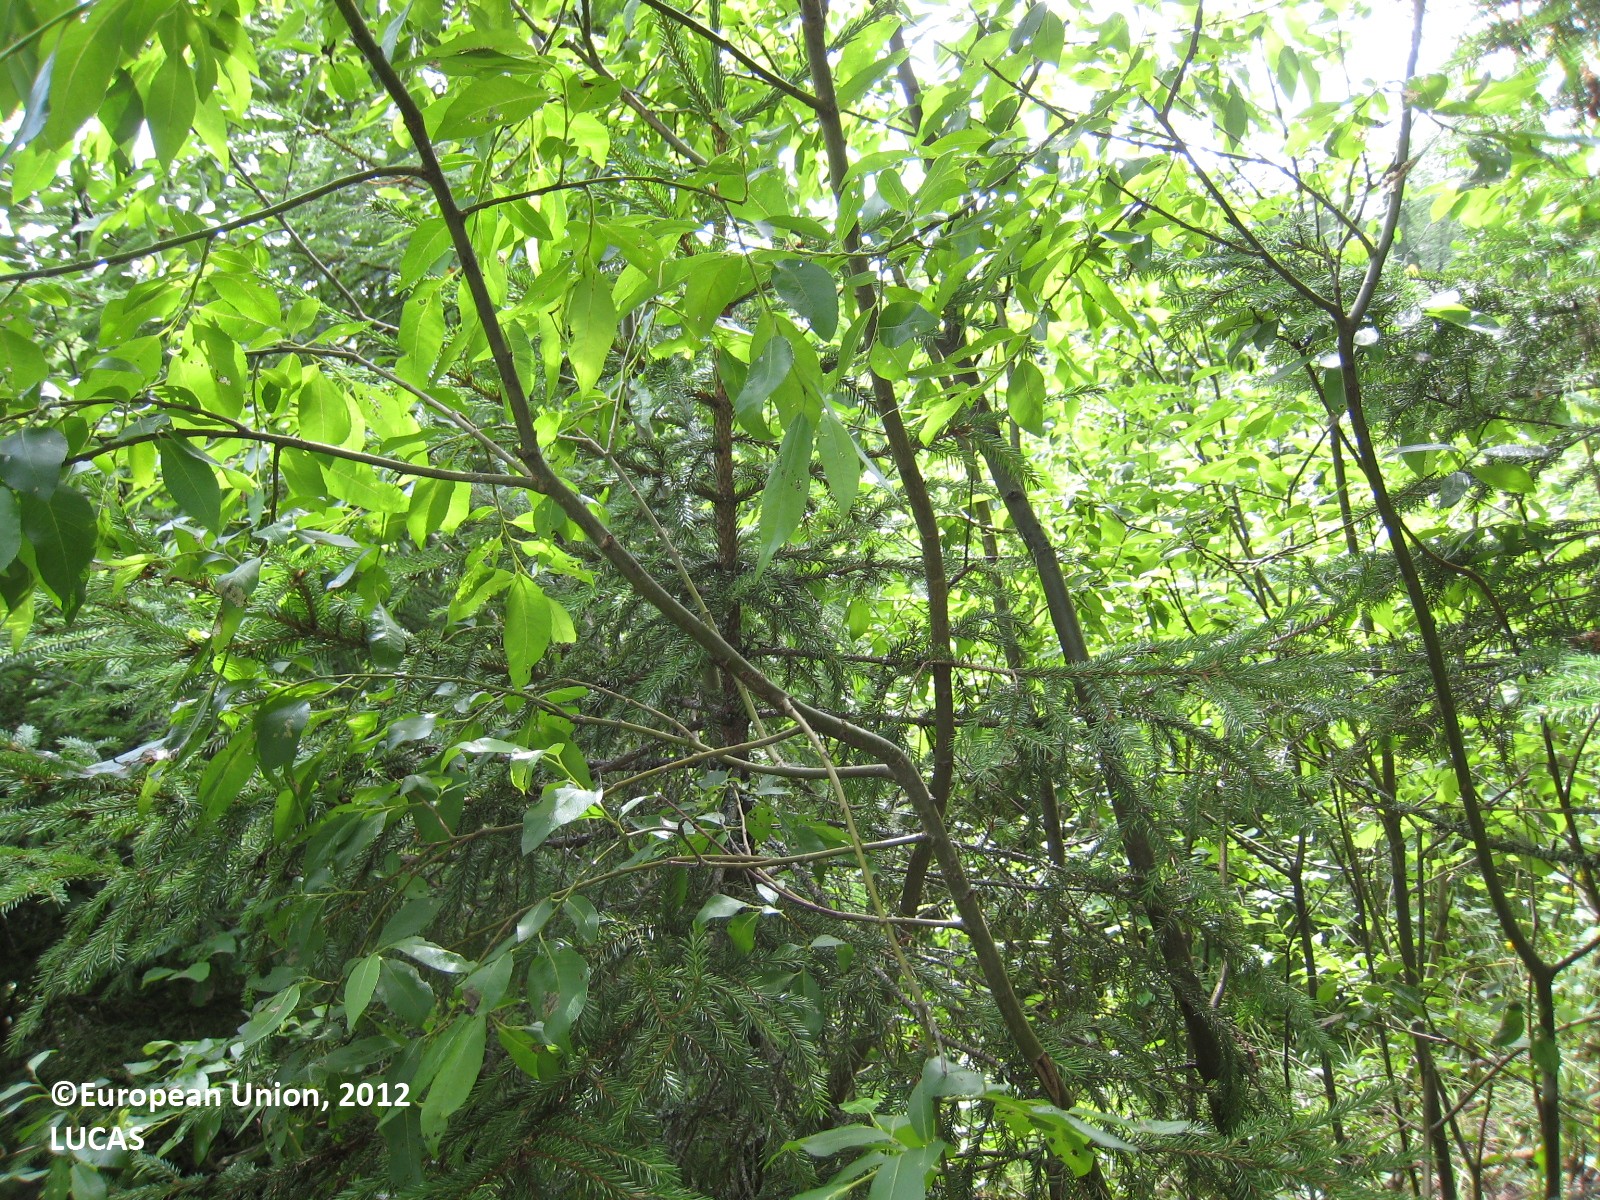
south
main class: Woodland
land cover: Other mixed woodland
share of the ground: > 75 %
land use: Semi-natural and natural areas not in use
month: July
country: FI
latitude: 63.2678
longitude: 26.8165
